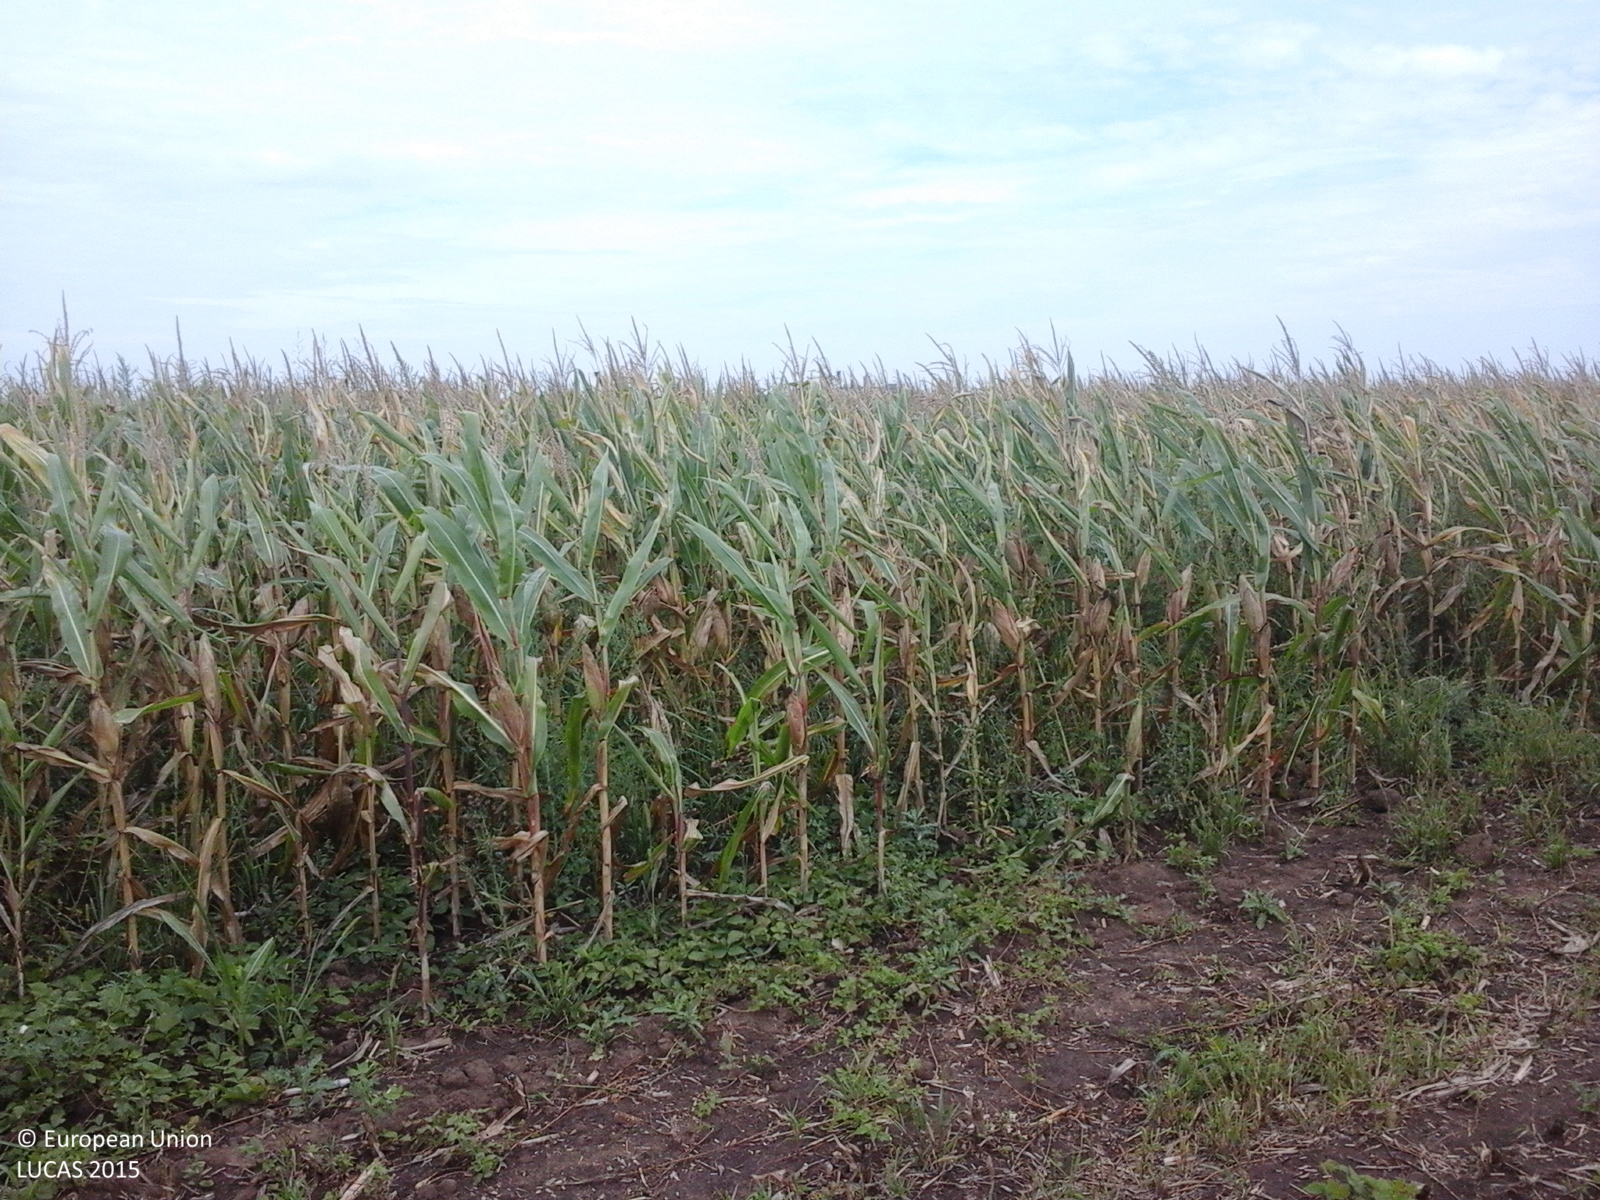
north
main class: Cropland
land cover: Maize
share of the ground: < 10 %
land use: Agriculture (excluding fallow land and kitchen gardens)
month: August
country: RO
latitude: 46.3103
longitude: 21.5028
